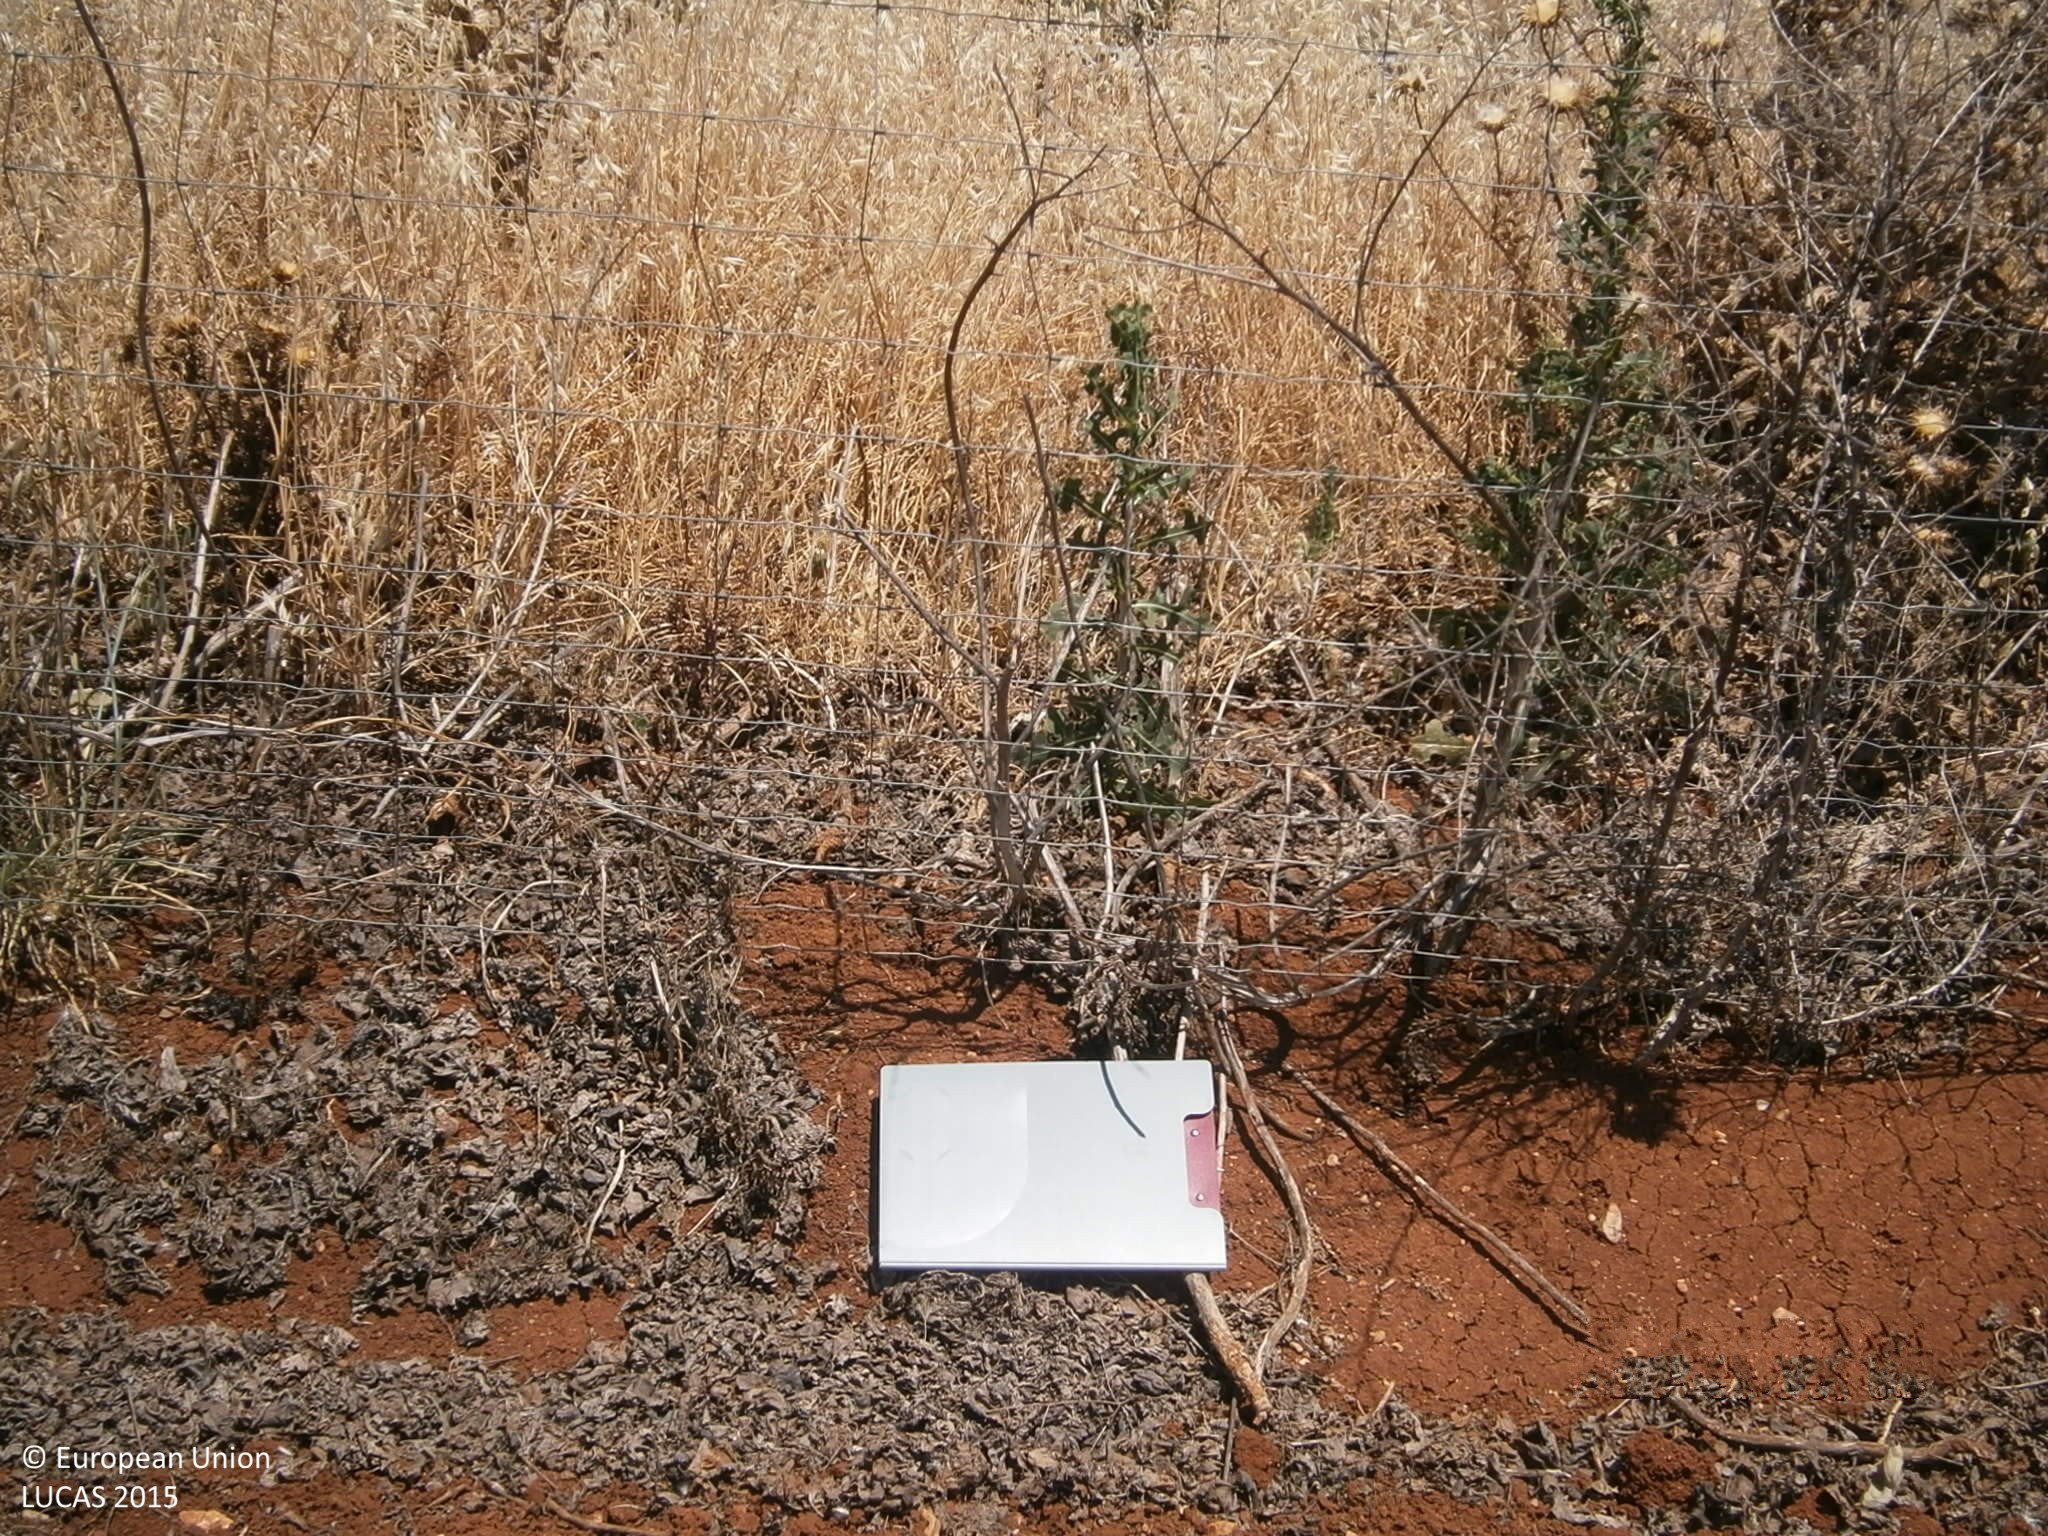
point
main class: Grassland
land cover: Spontaneously vegetated surfaces
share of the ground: > 75 %
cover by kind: herbaceous plants 100 %
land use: Road transport
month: June
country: ES
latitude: 38.5877
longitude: -6.3659
